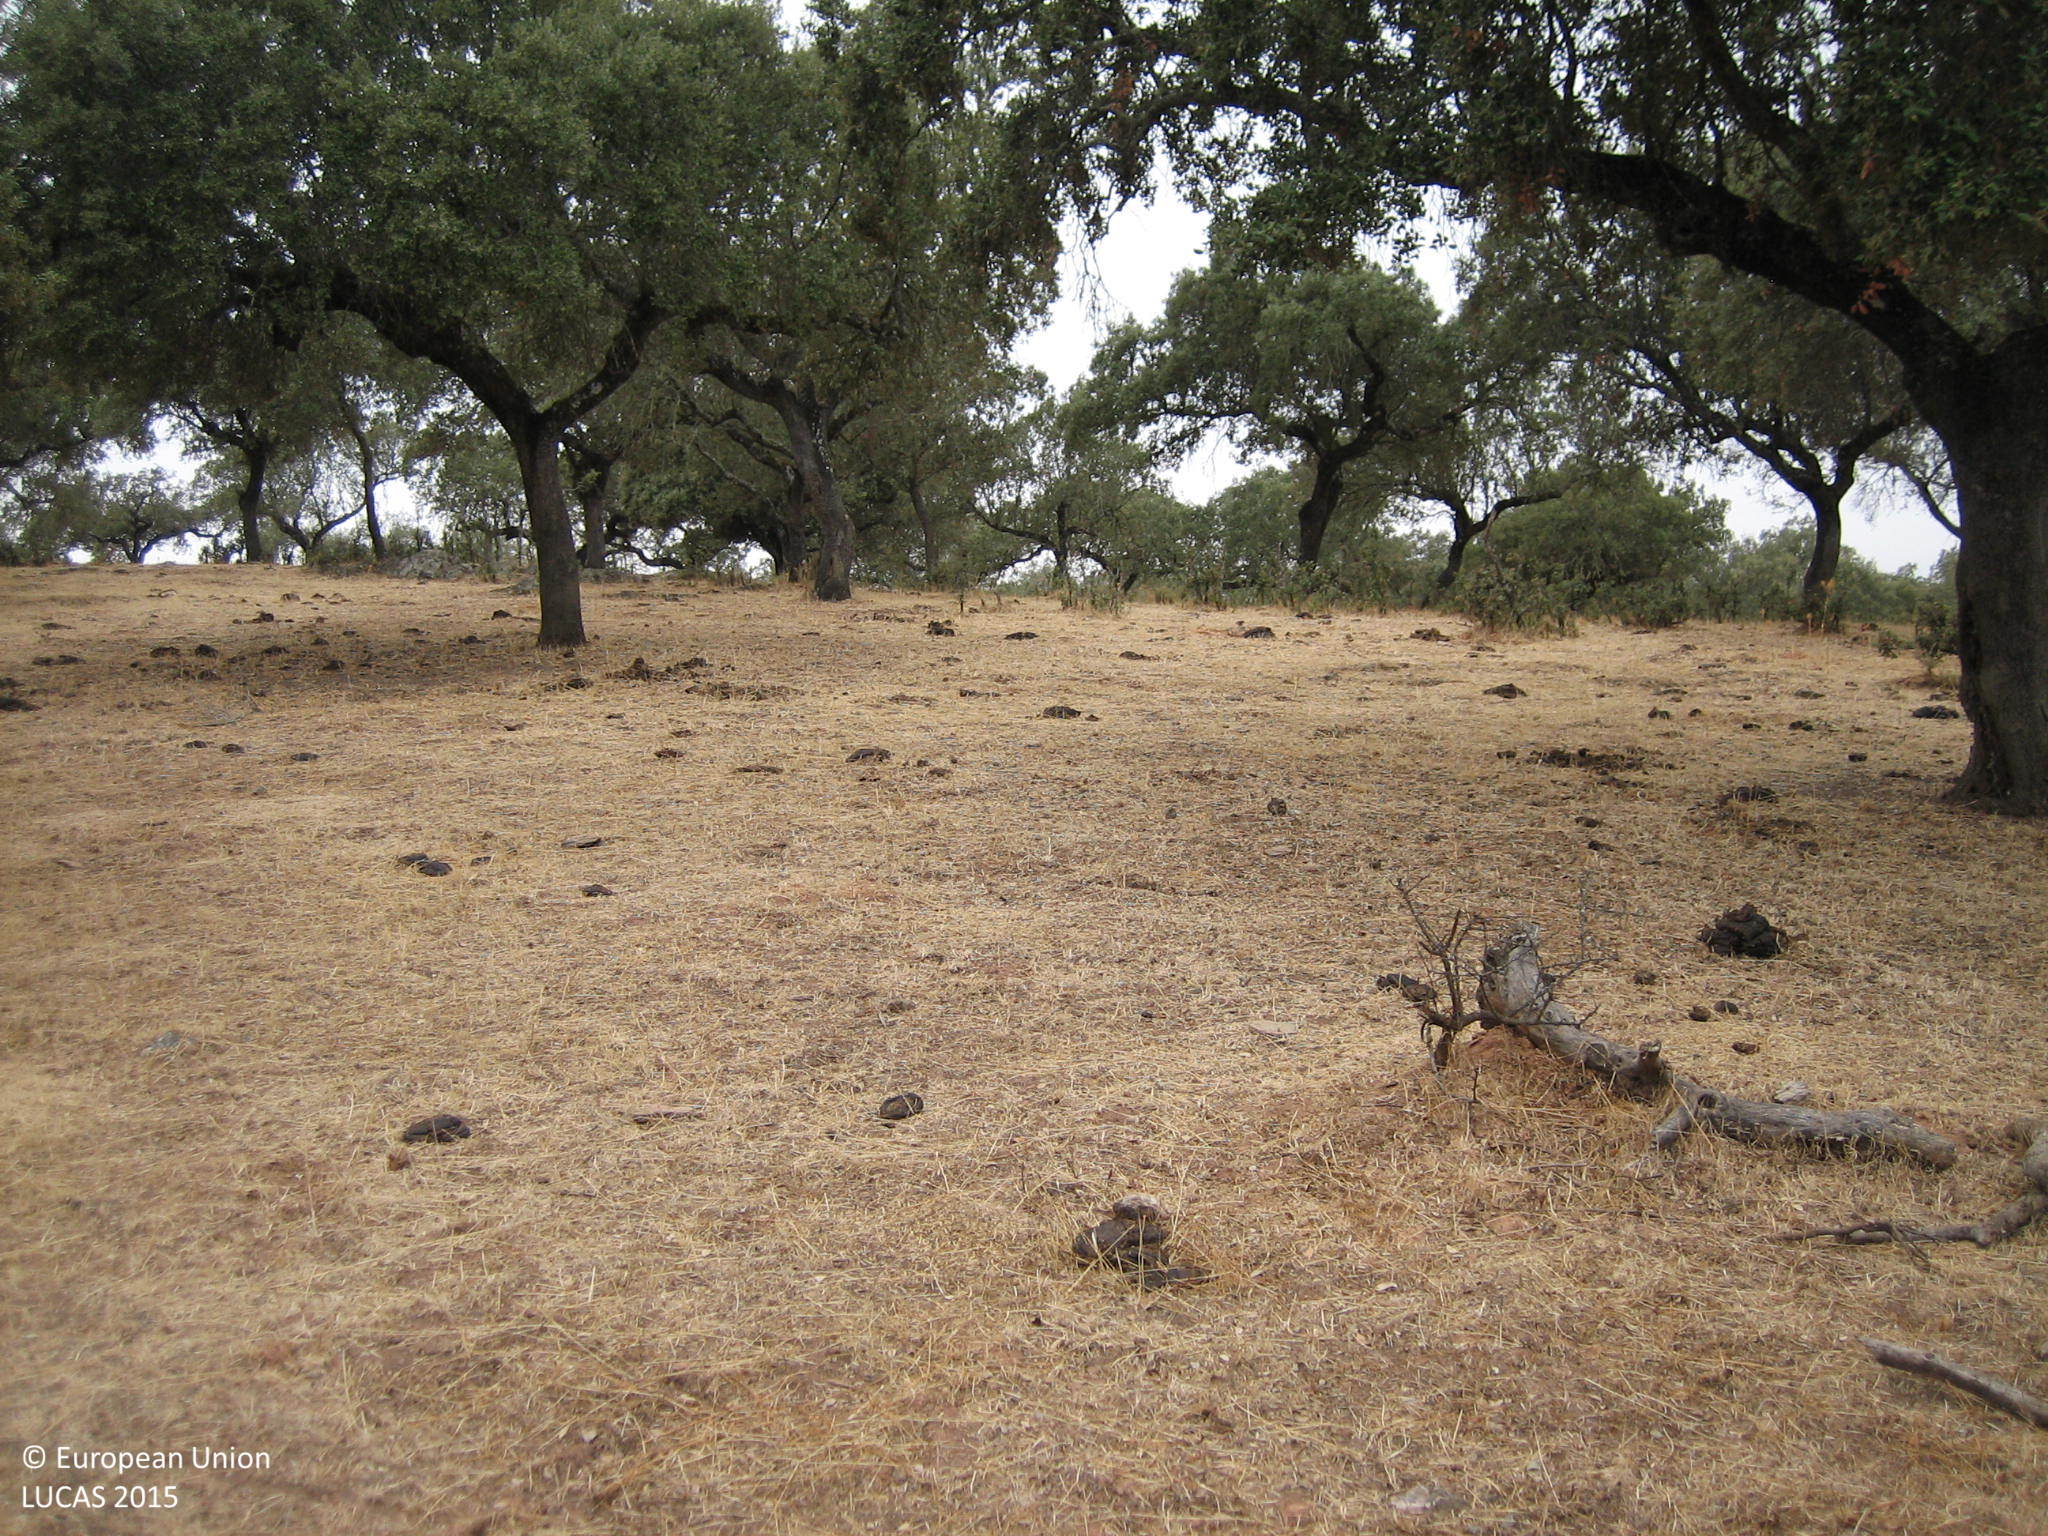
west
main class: Woodland
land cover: Broadleaved woodland
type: broadleaved evergreen forest
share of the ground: 25 - 50 %
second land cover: Grassland without tree/shrub cover
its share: > 75 %
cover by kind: herbaceous plants 60 %, broadleaved forest trees 40 %
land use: Forestry
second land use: Agriculture (excluding fallow land and kitchen gardens)
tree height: > 5 m
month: September
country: ES
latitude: 38.3177
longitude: -7.1626
